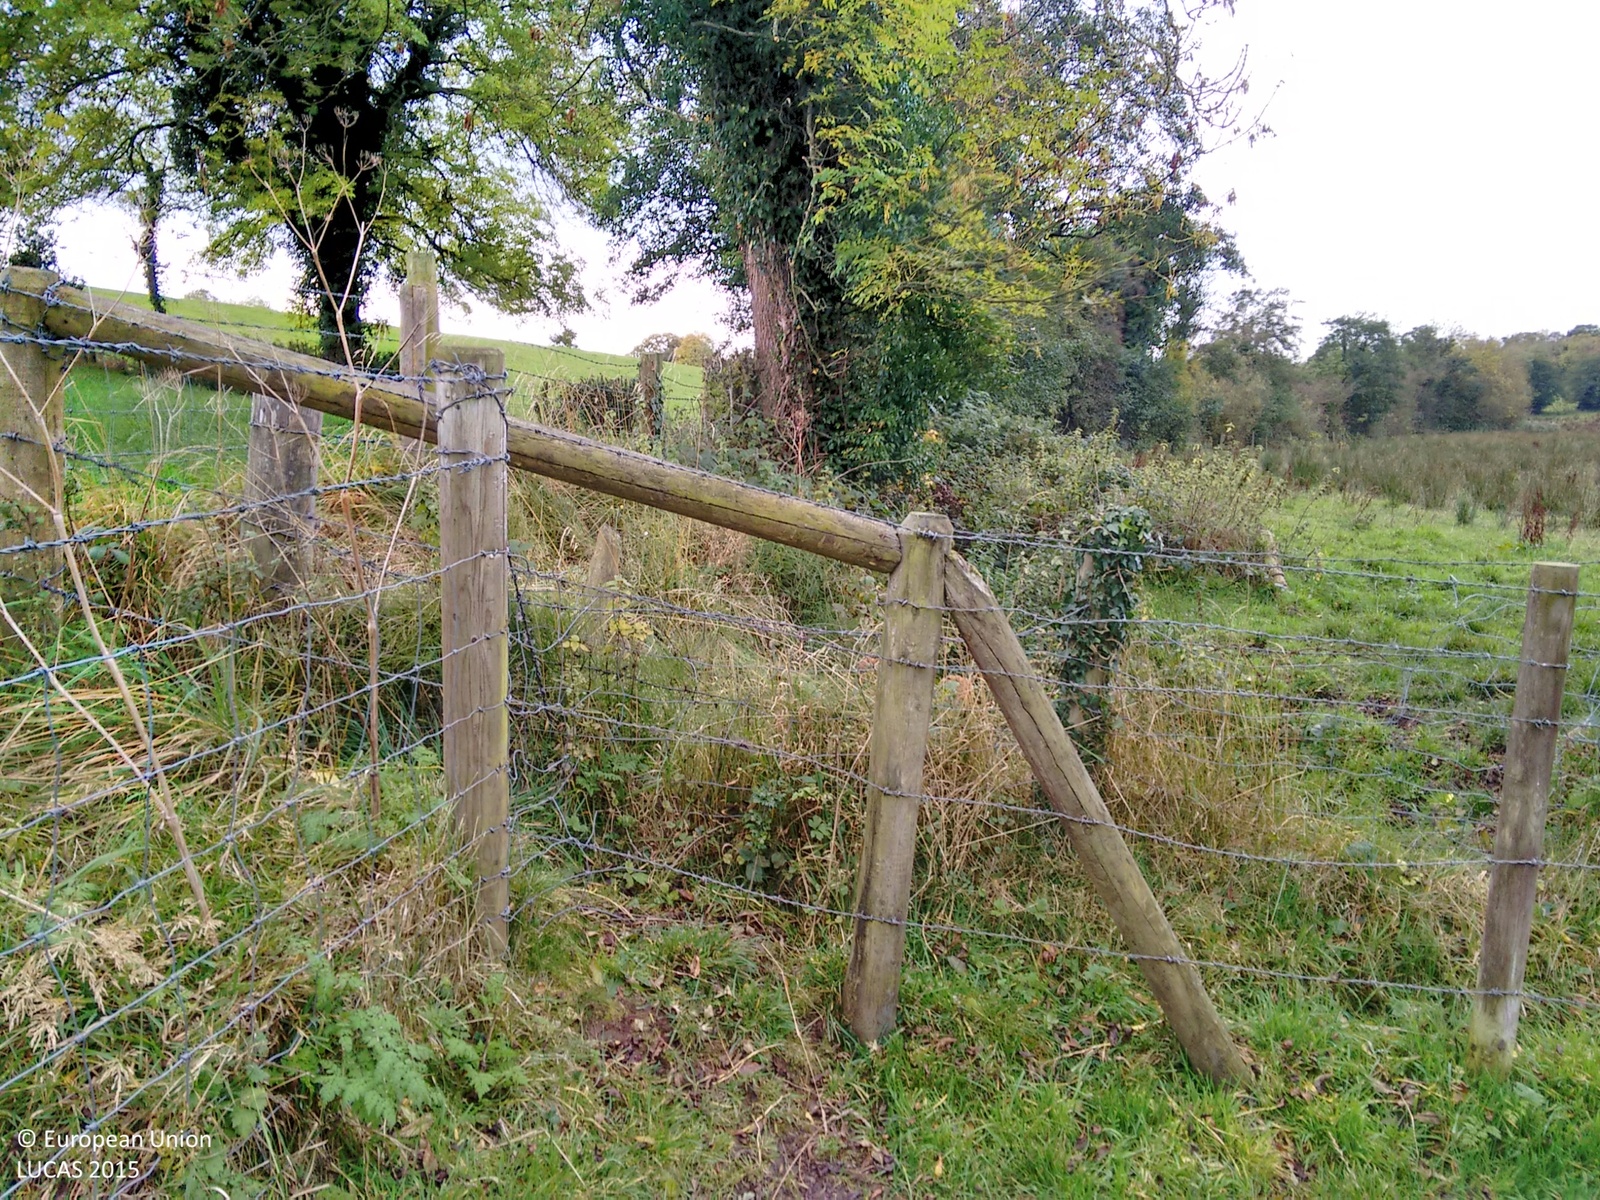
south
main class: Grassland
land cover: Grassland without tree/shrub cover
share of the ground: > 75 %
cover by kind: herbaceous plants 100 %
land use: Agriculture (excluding fallow land and kitchen gardens)
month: October
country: GB
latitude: 54.3138
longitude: -7.4475
